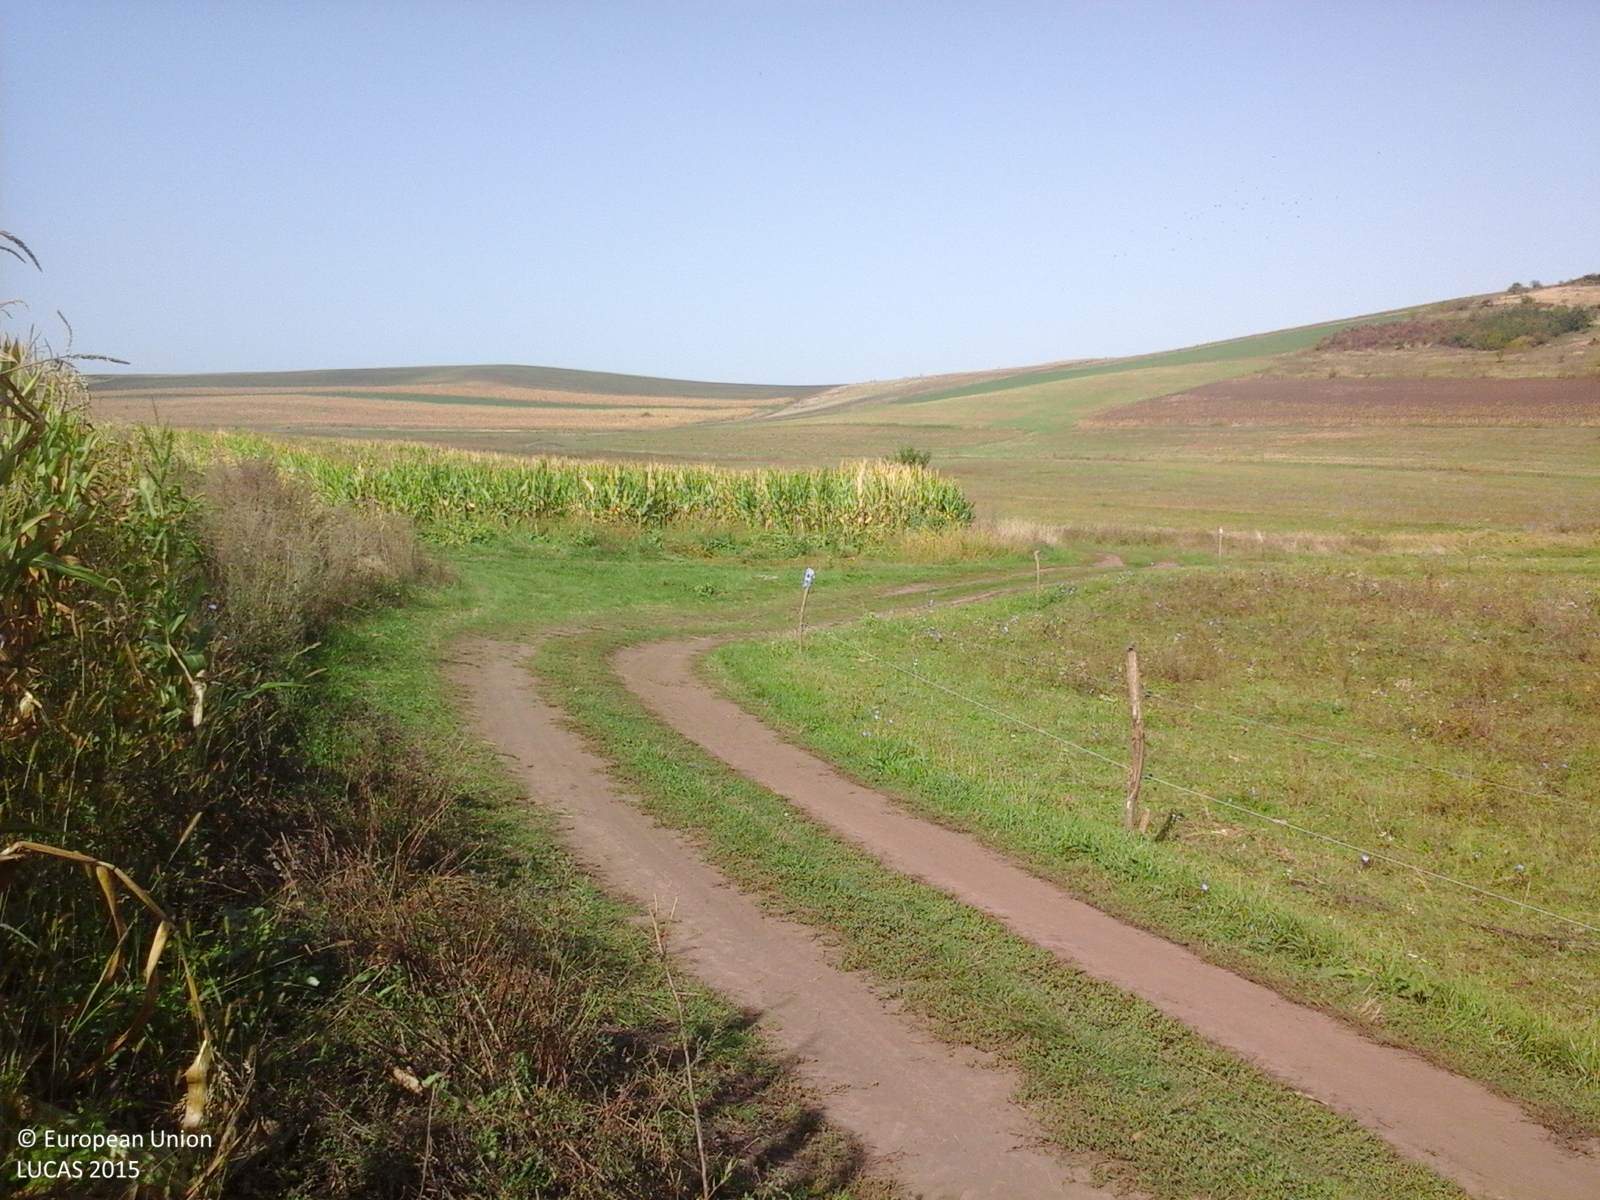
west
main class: Cropland
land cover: Maize
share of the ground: > 75 %
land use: Agriculture (excluding fallow land and kitchen gardens)
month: September
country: RO
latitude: 46.6681
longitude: 24.1314
